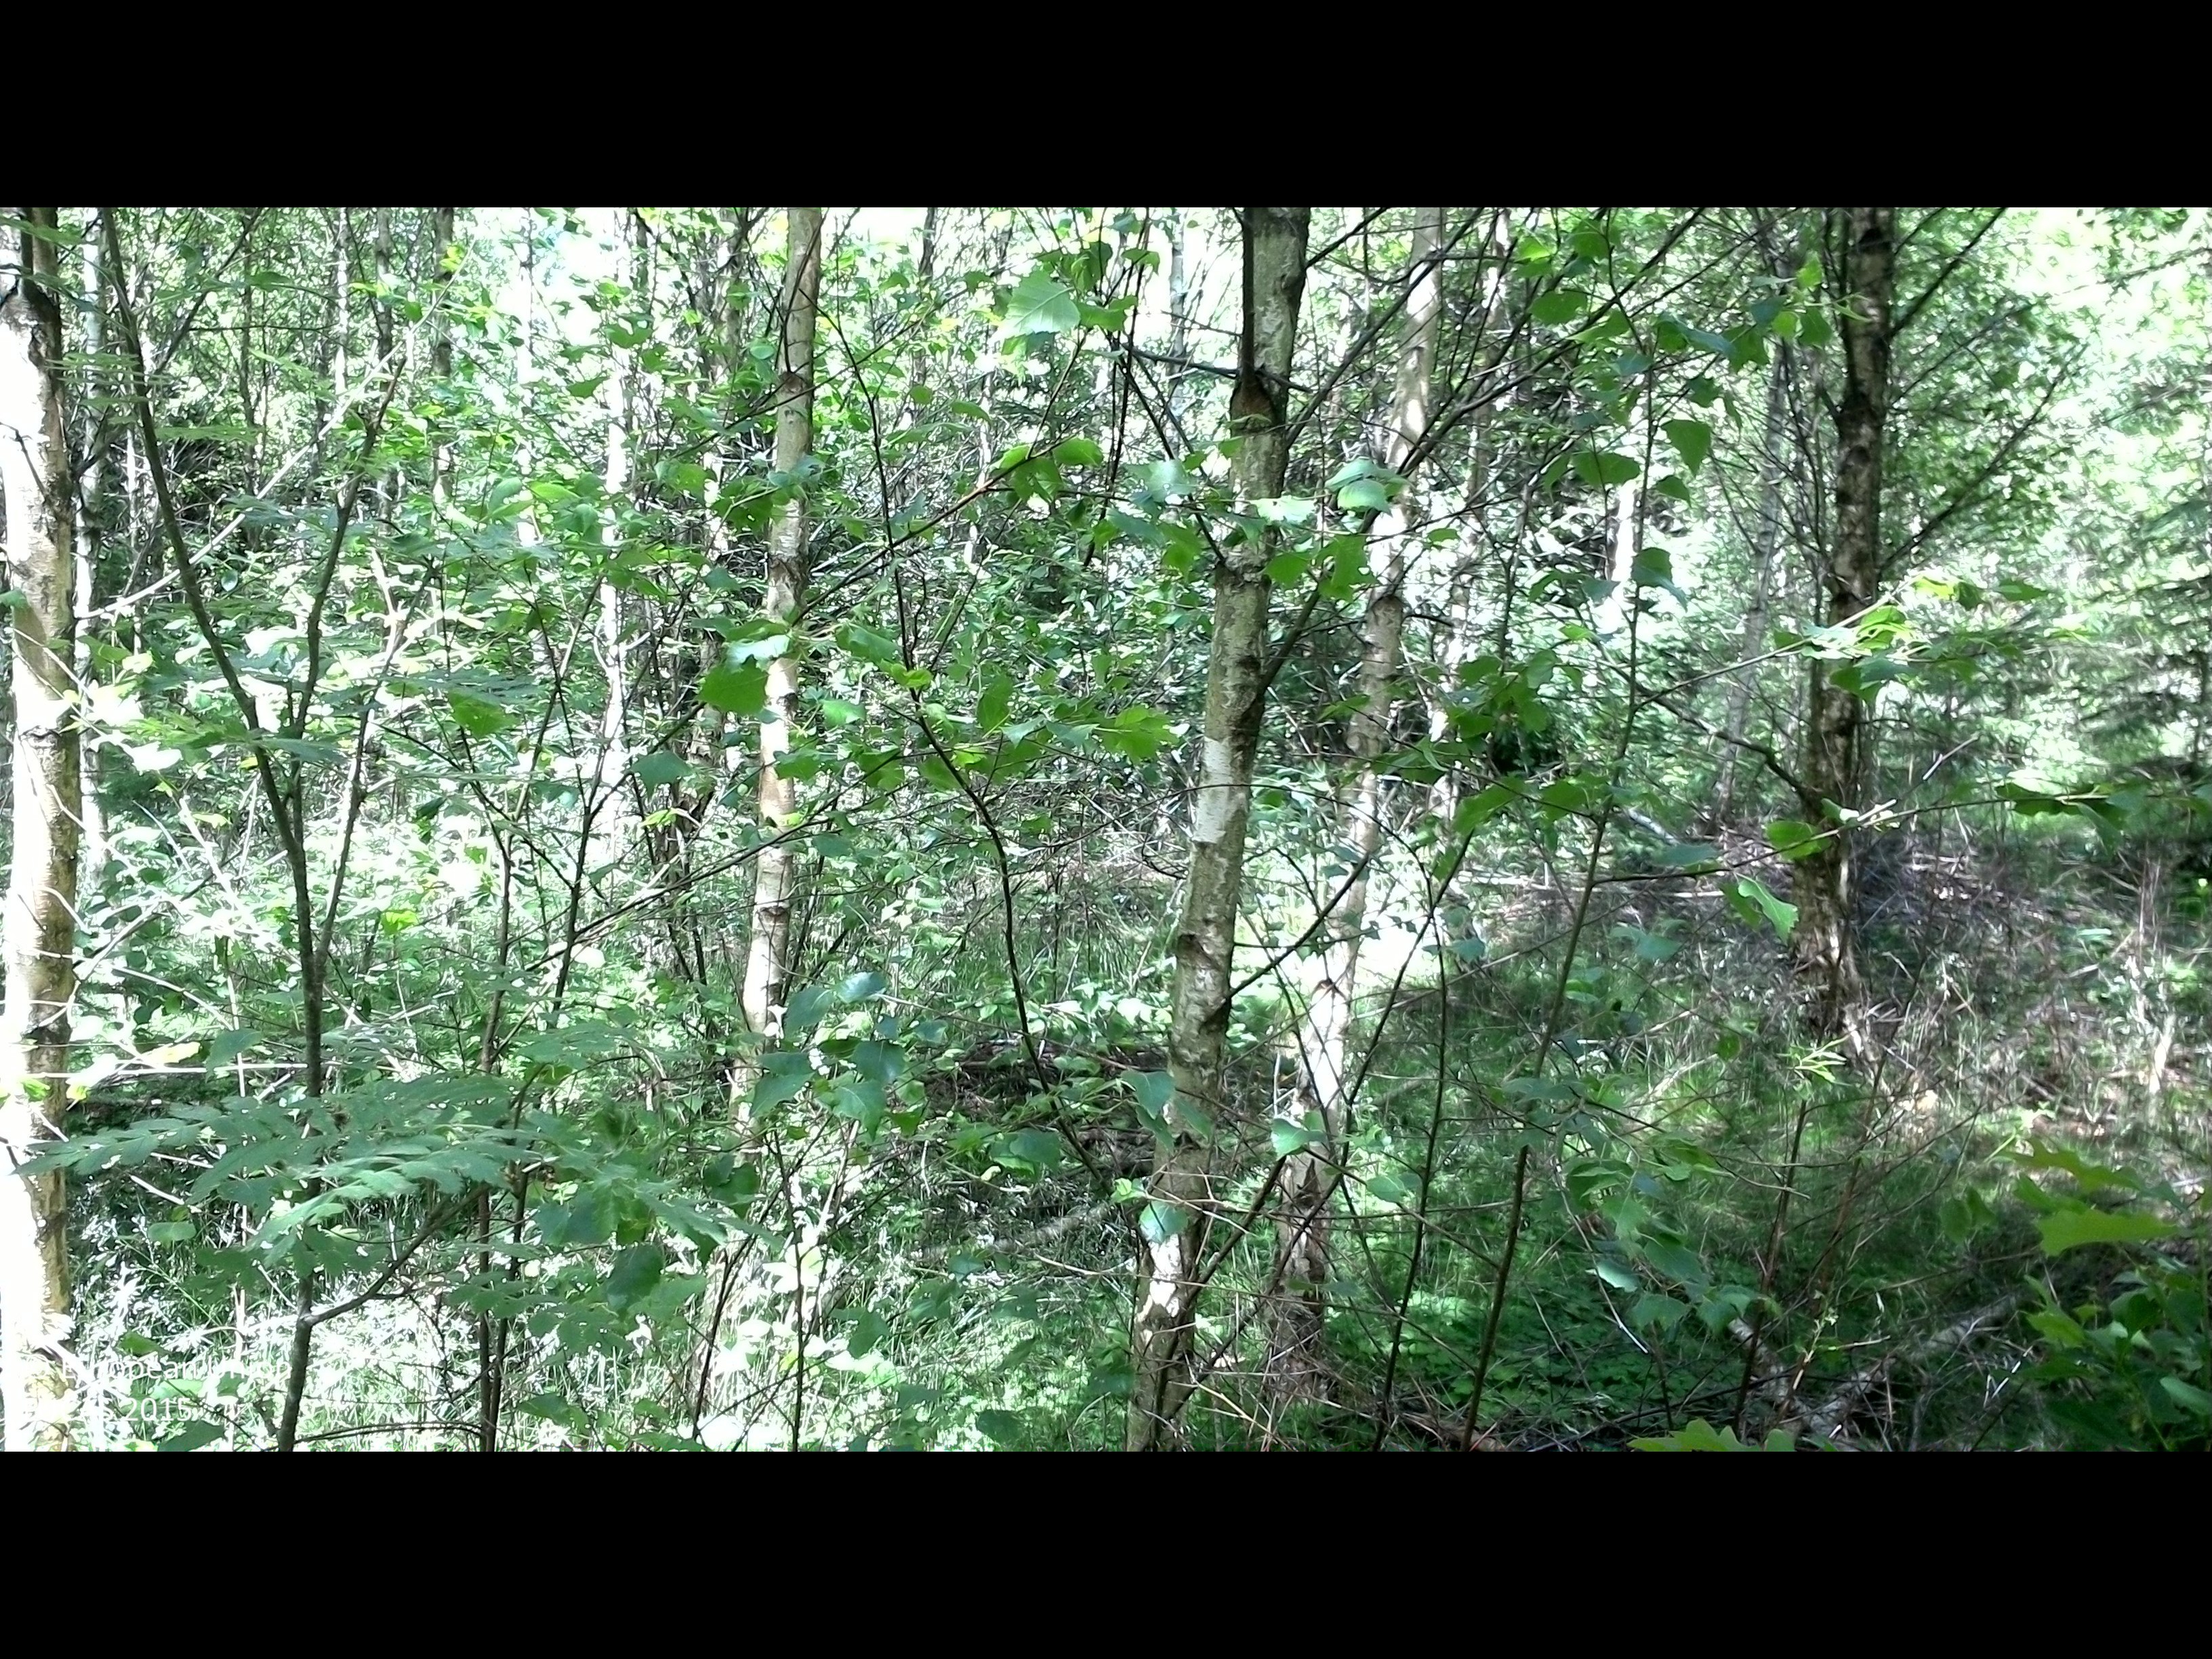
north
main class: Woodland
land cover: Broadleaved woodland
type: boreal forest
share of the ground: > 75 %
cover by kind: broadleaved forest trees 75 %, shrubs 10 %, herbaceous plants 10 %, coniferous forest trees 5 %
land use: Forestry
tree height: < 5 m
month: June
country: SE
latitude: 56.3329
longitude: 16.0661
